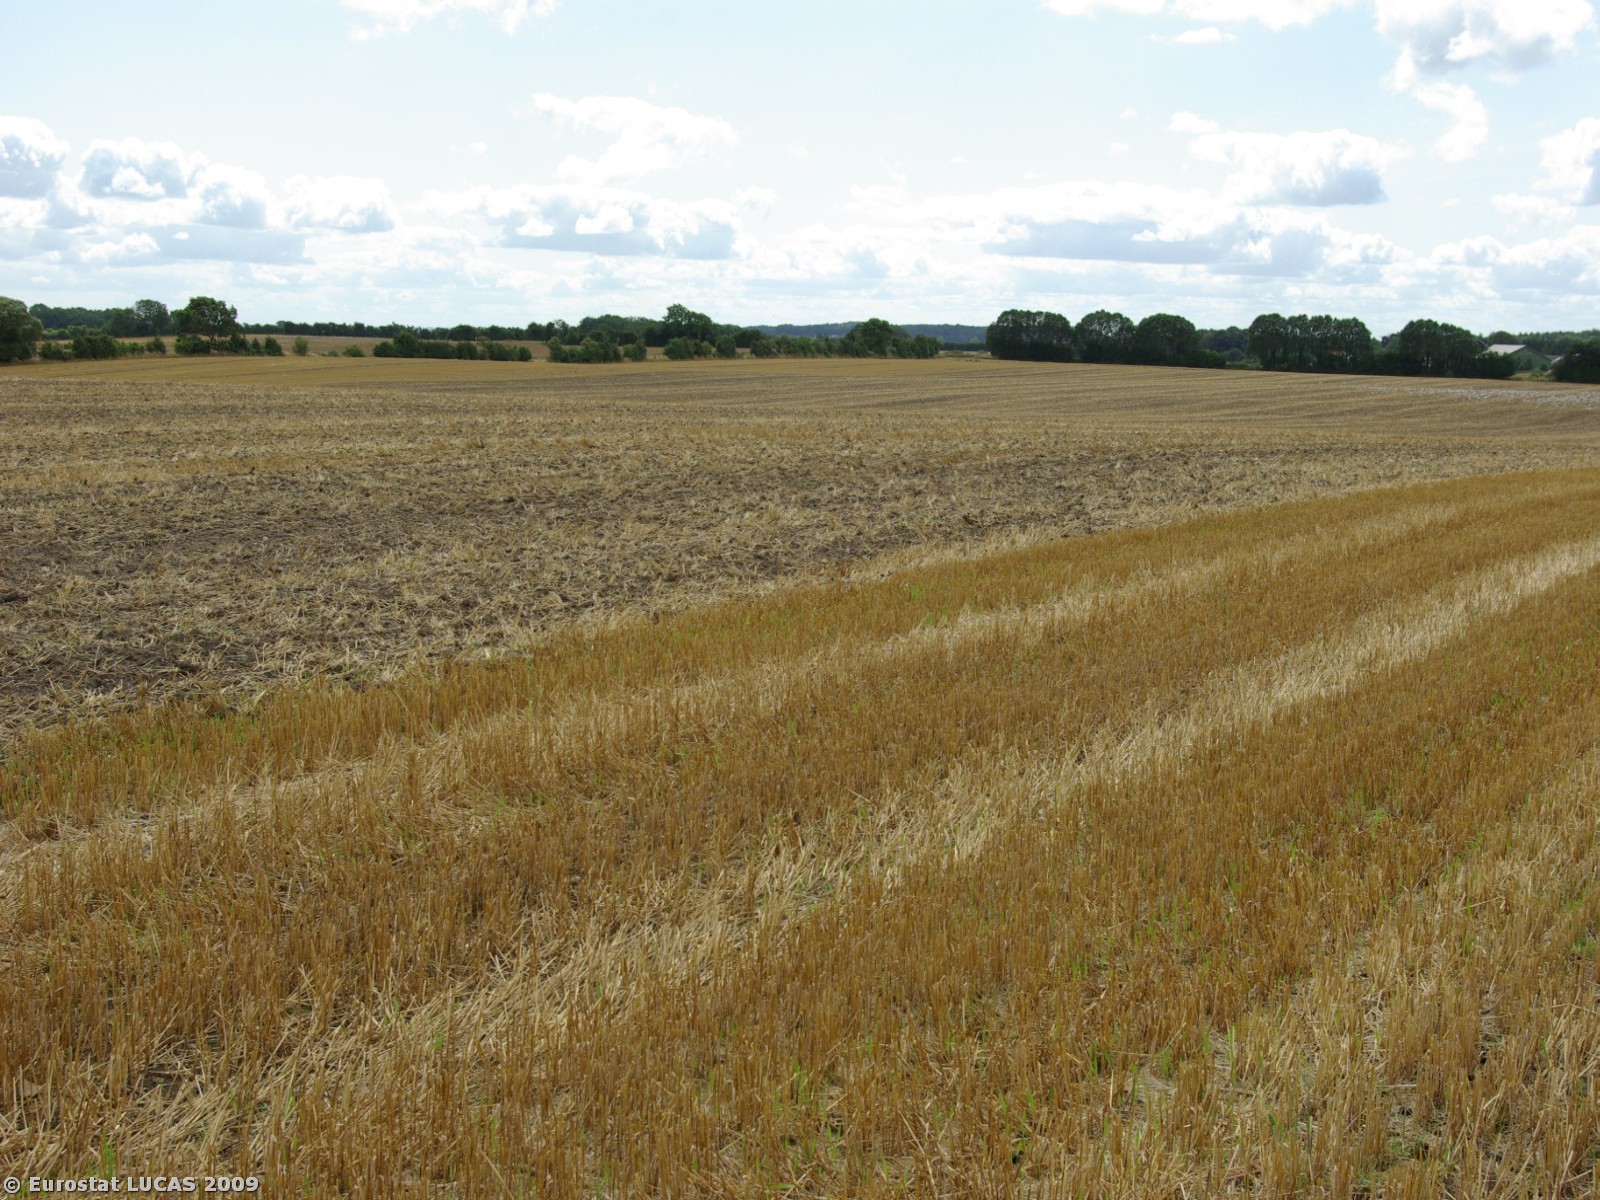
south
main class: Cropland
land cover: Common wheat
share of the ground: > 75 %
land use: Agriculture (excluding fallow land and kitchen gardens)
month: July
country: DK
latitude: 55.2526
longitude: 9.6699
